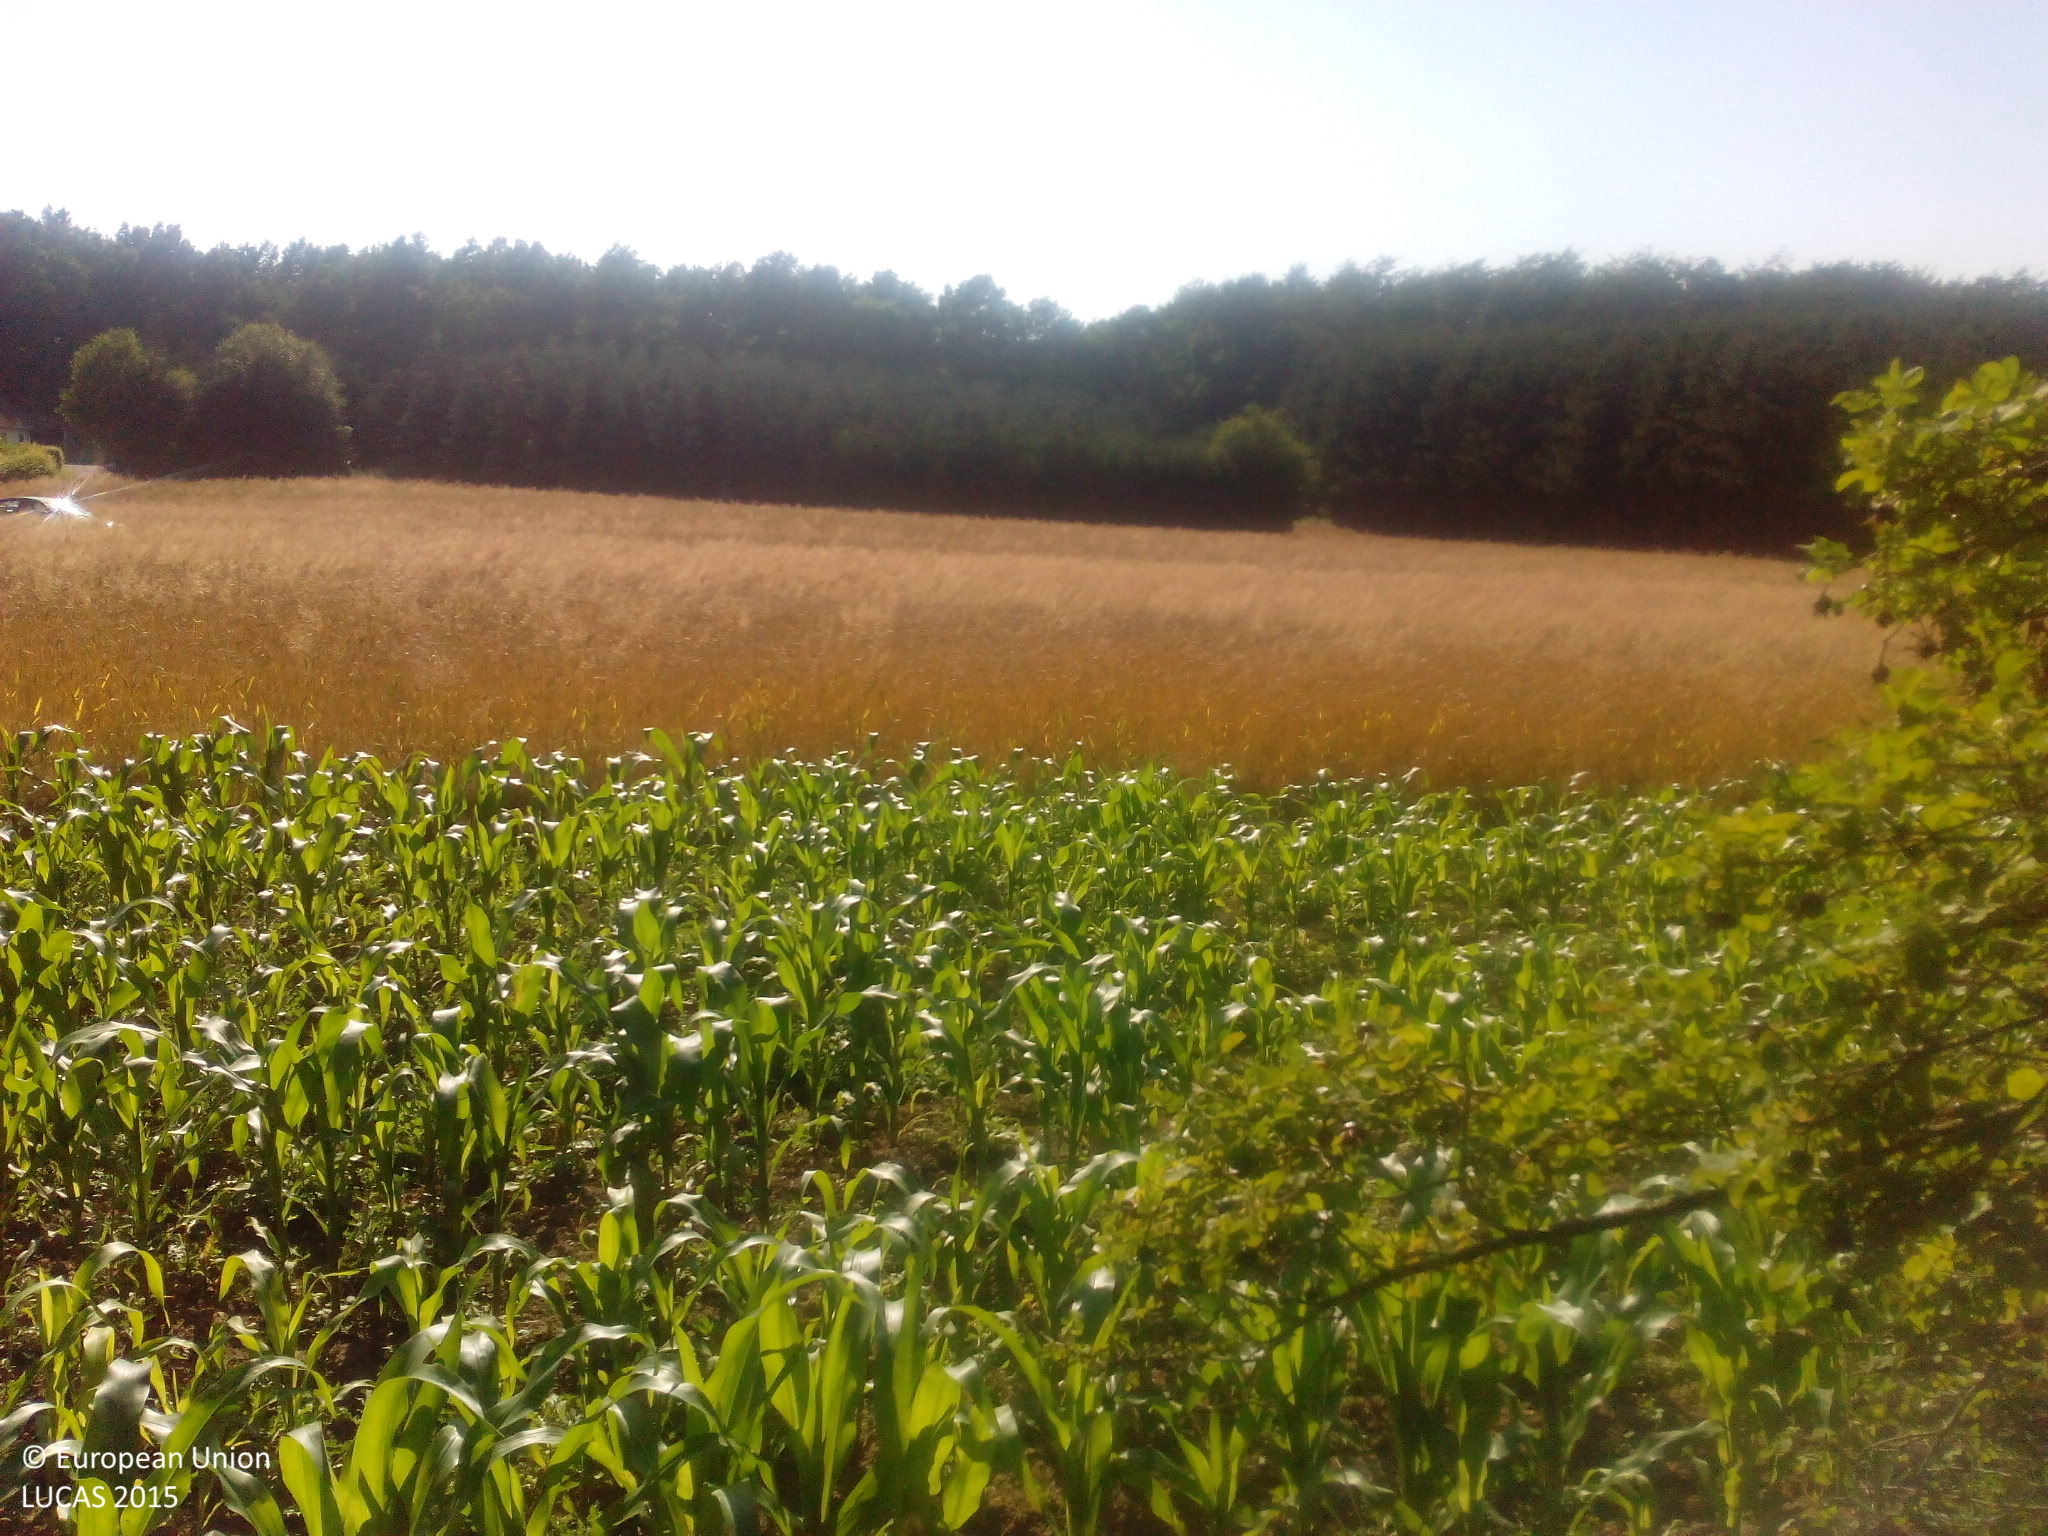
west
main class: Woodland
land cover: Spruce dominated mixed woodland
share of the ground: > 75 %
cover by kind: coniferous forest trees 60 %, broadleaved forest trees 40 %
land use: Semi-natural and natural areas not in use
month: August
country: DK
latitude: 55.6547
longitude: 11.7308
